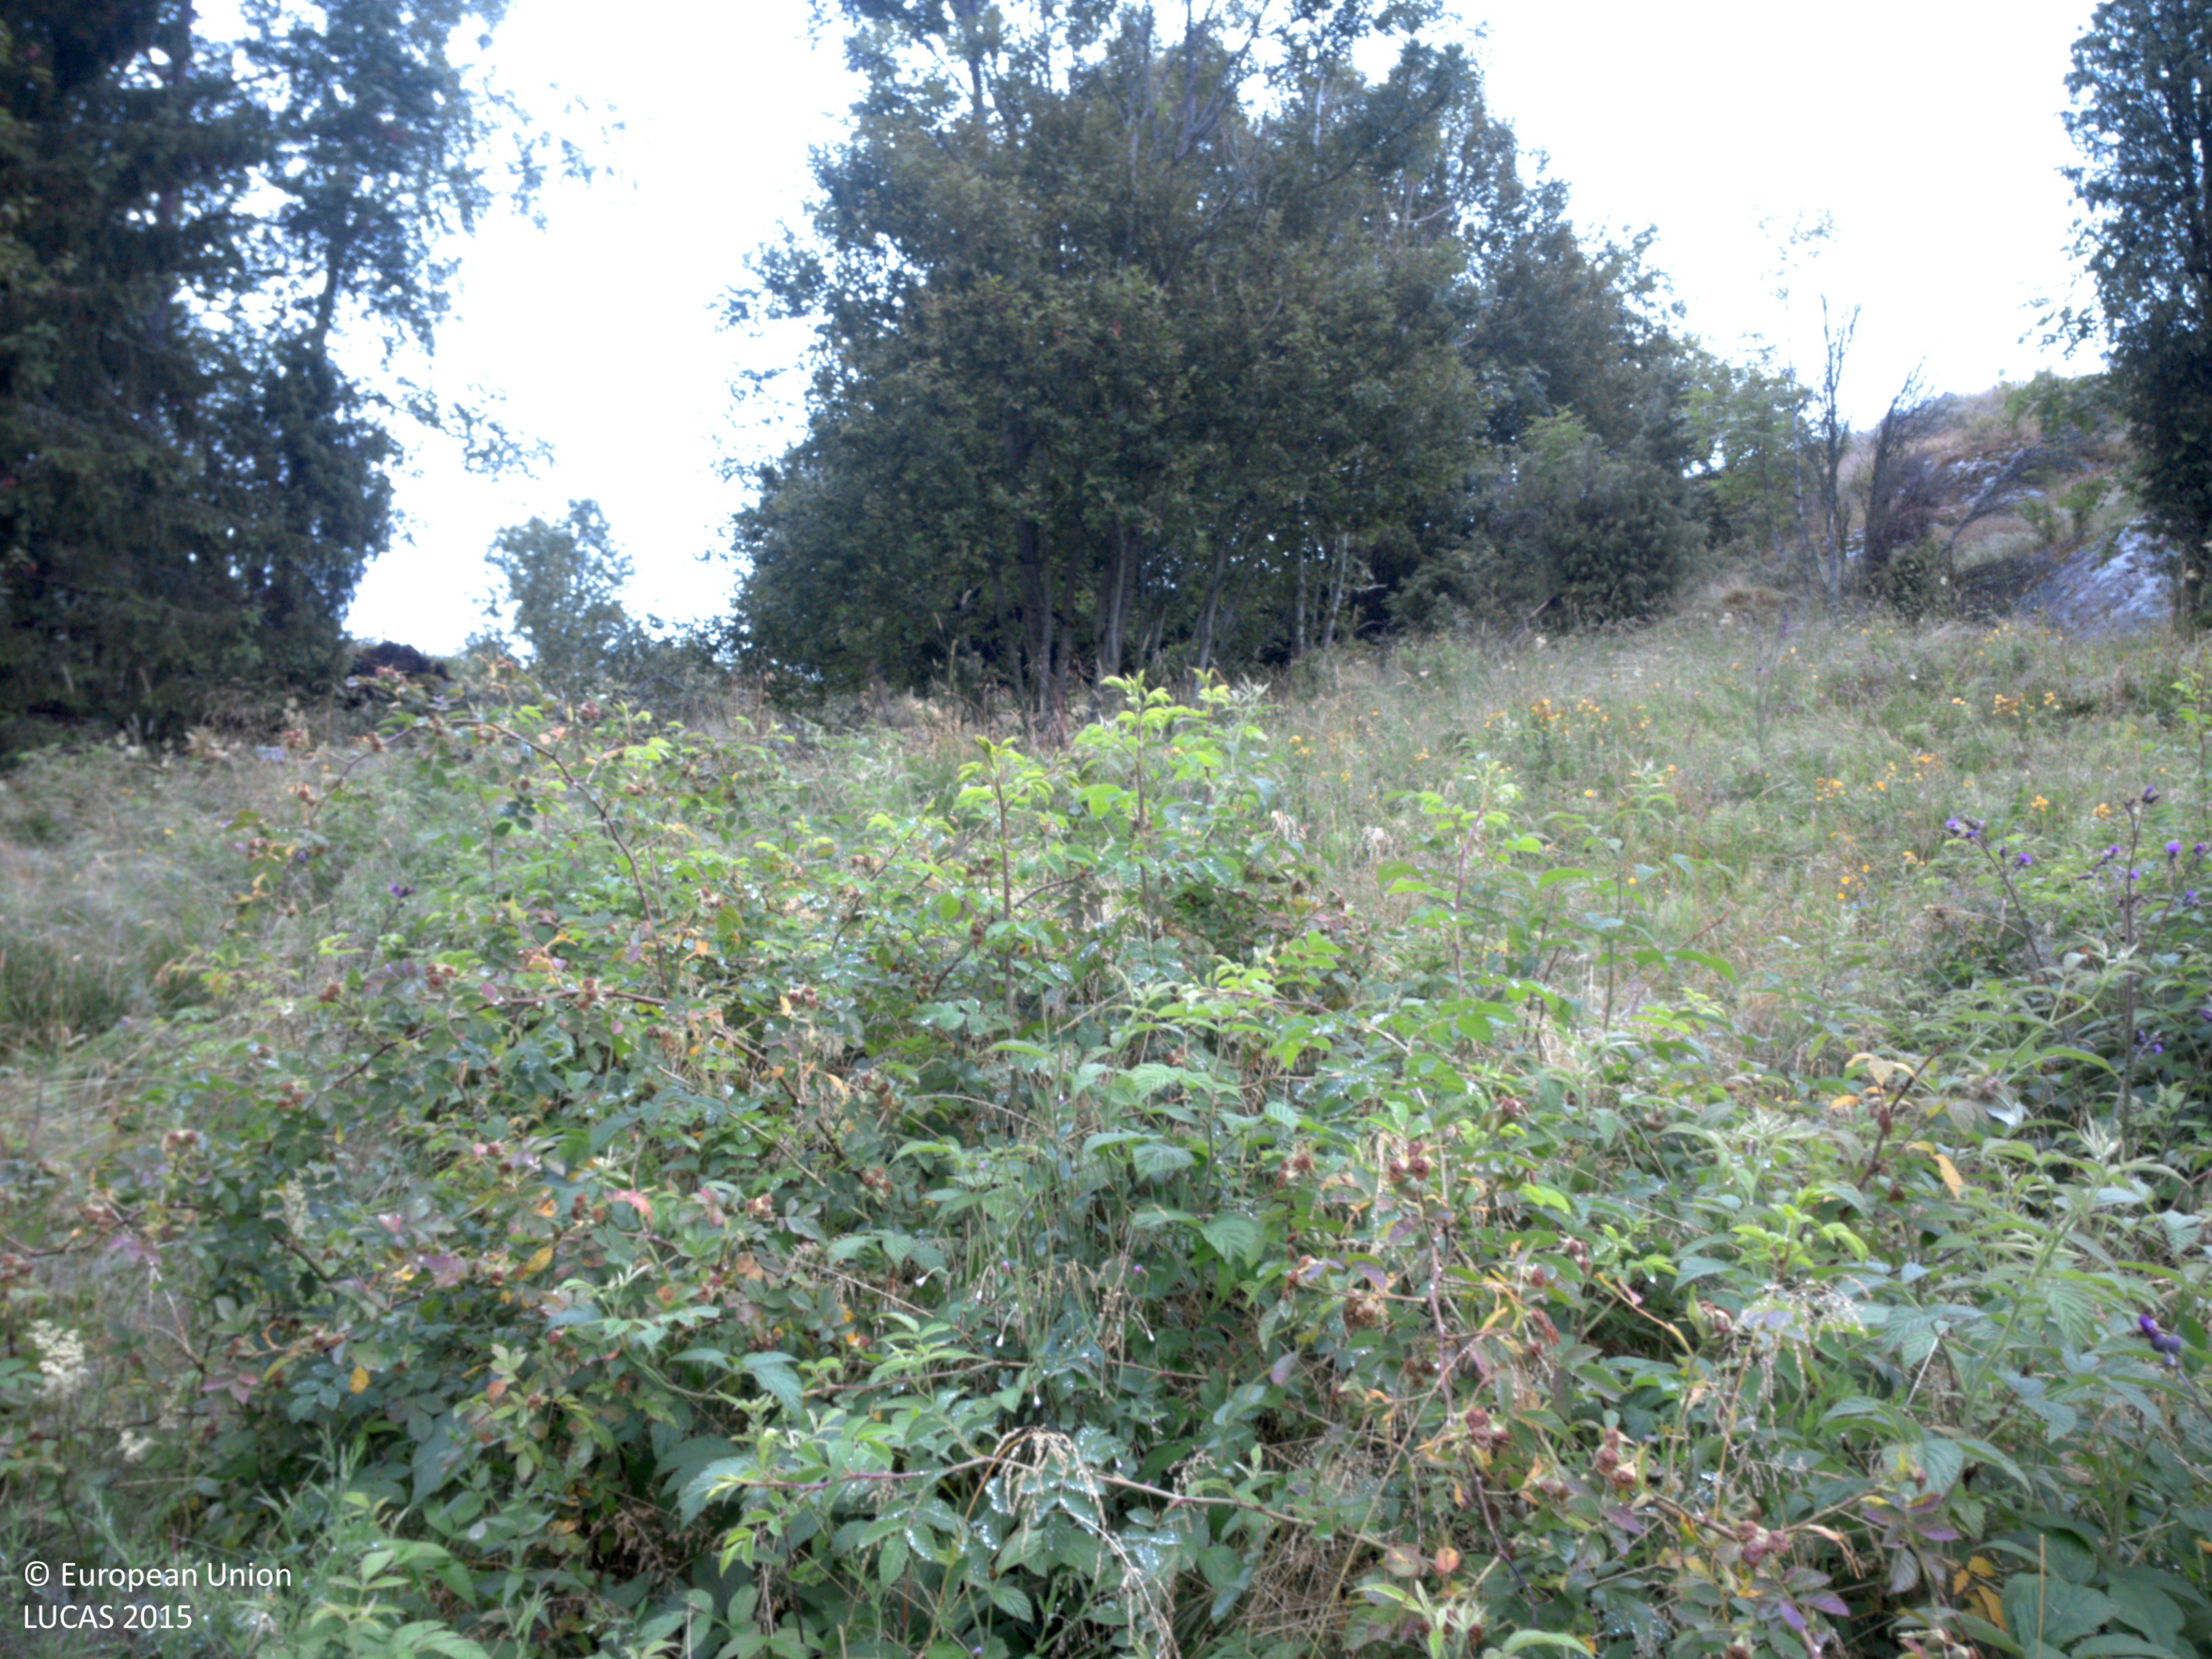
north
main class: Shrubland
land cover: Shrubland with sparse tree cover
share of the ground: > 75 %
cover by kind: herbaceous plants 80 %, shrubs 15 %, broadleaved forest trees 5 %
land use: Agriculture (excluding fallow land and kitchen gardens)
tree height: < 5 m
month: July
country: SE
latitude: 58.7281
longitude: 11.8784
